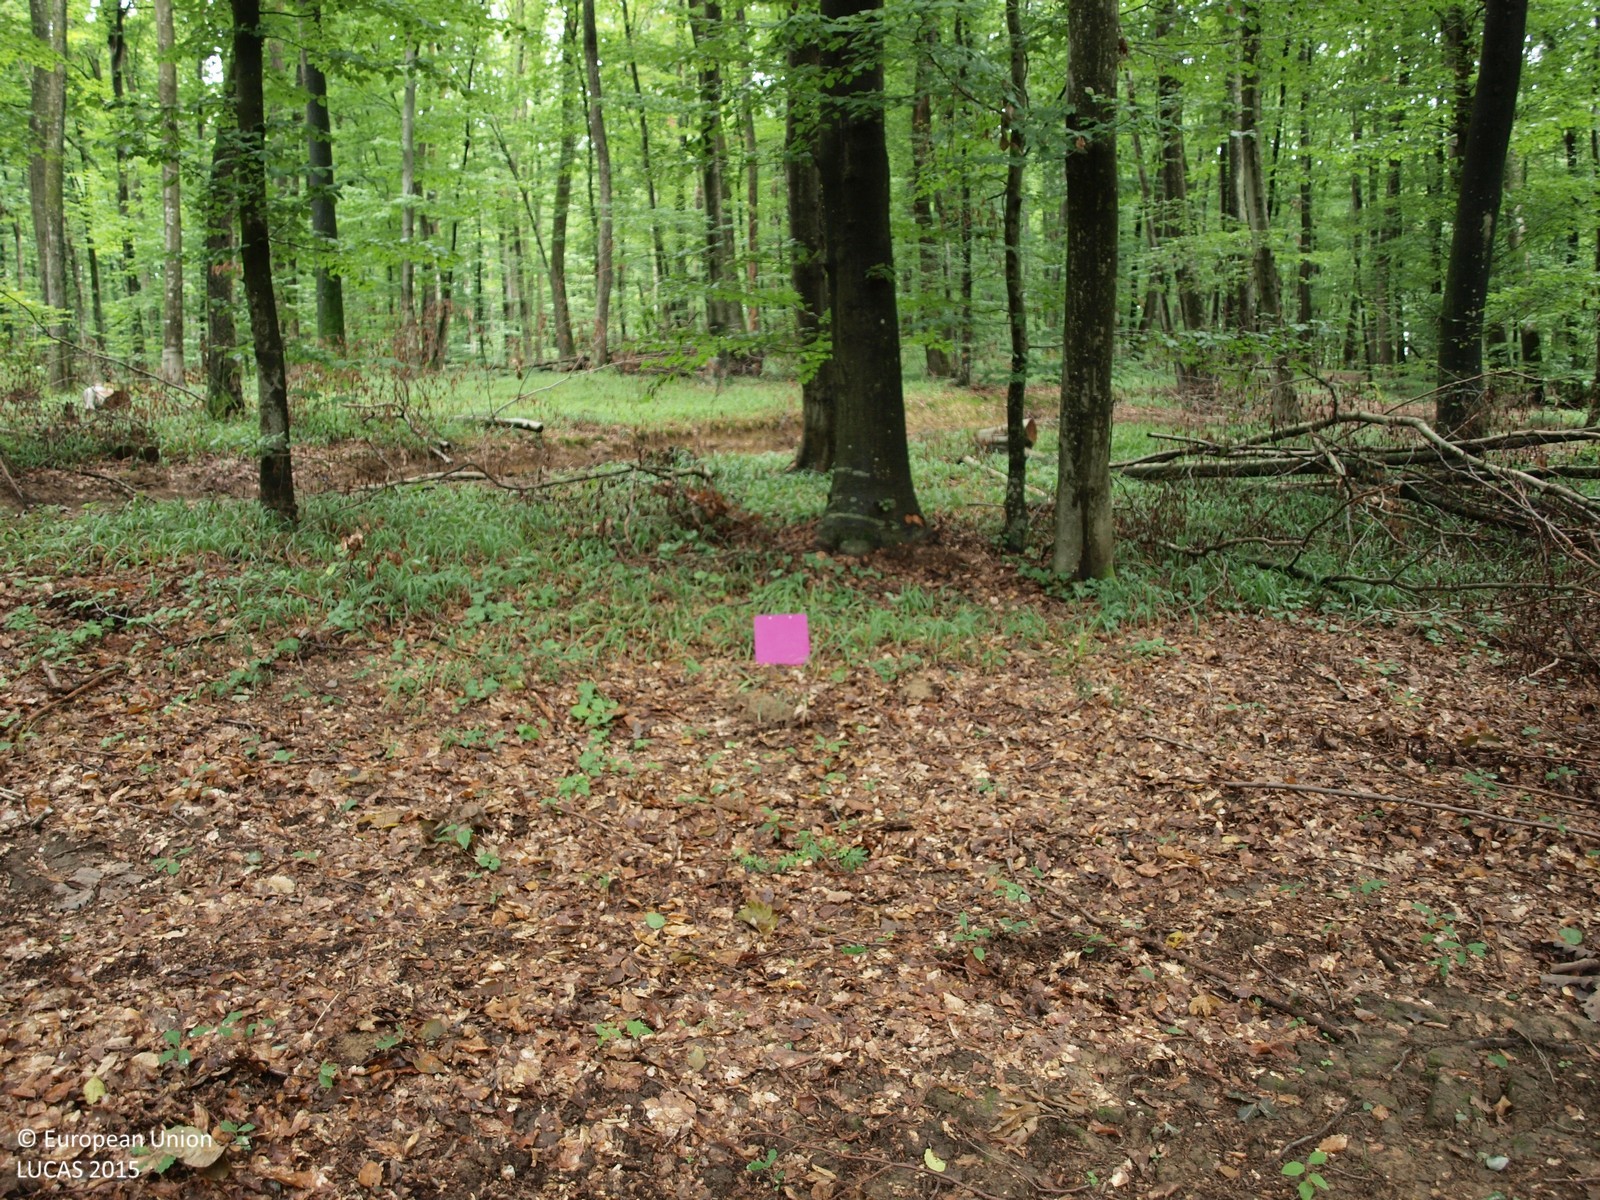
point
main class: Woodland
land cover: Broadleaved woodland
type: beech forest
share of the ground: > 75 %
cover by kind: broadleaved forest trees 100 %
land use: Forestry
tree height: > 5 m
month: July
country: HR
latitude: 46.0559
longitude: 16.3199
